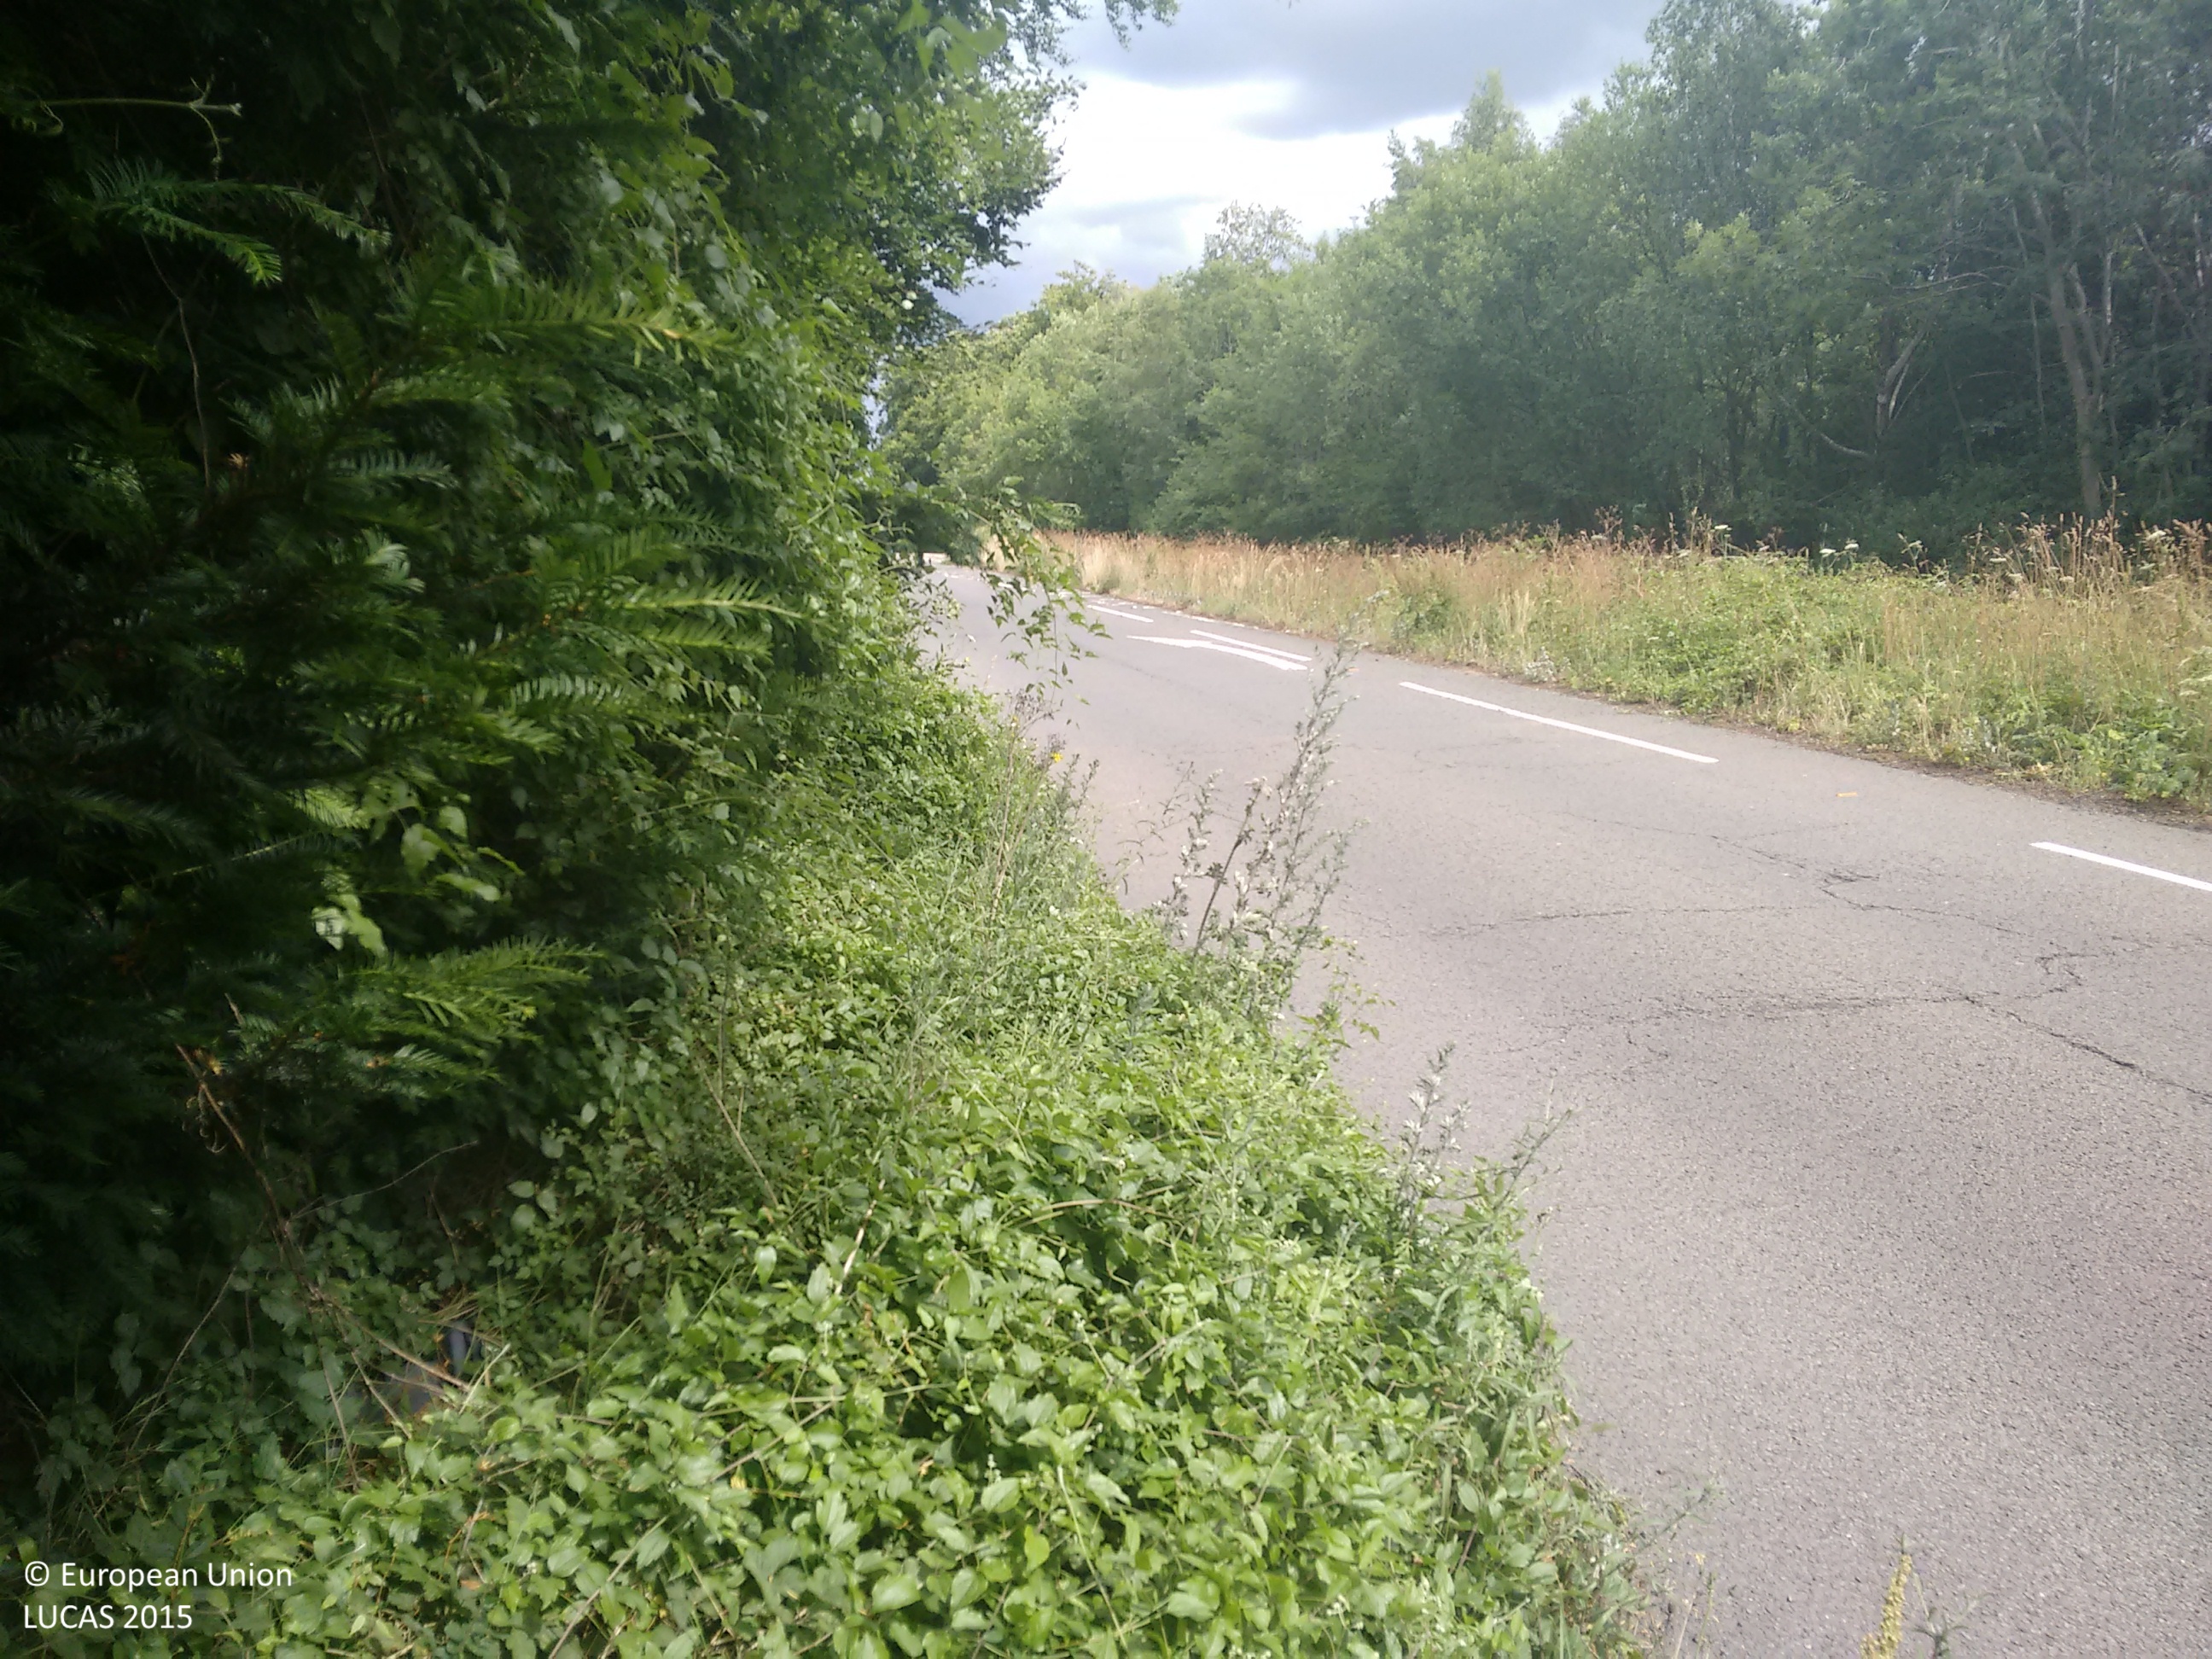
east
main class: Woodland
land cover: Other mixed woodland
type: hemiboreal forest and nemoral coniferous forest and mixed broadleaved-coniferous forest
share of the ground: > 75 %
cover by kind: coniferous forest trees 50 %, broadleaved forest trees 50 %
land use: Road transport
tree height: > 5 m
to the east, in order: Other mixed woodland; Paved roads, cycling and walking lanes; Broadleaved woodland
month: July
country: GB
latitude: 51.2283
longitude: -0.6225
